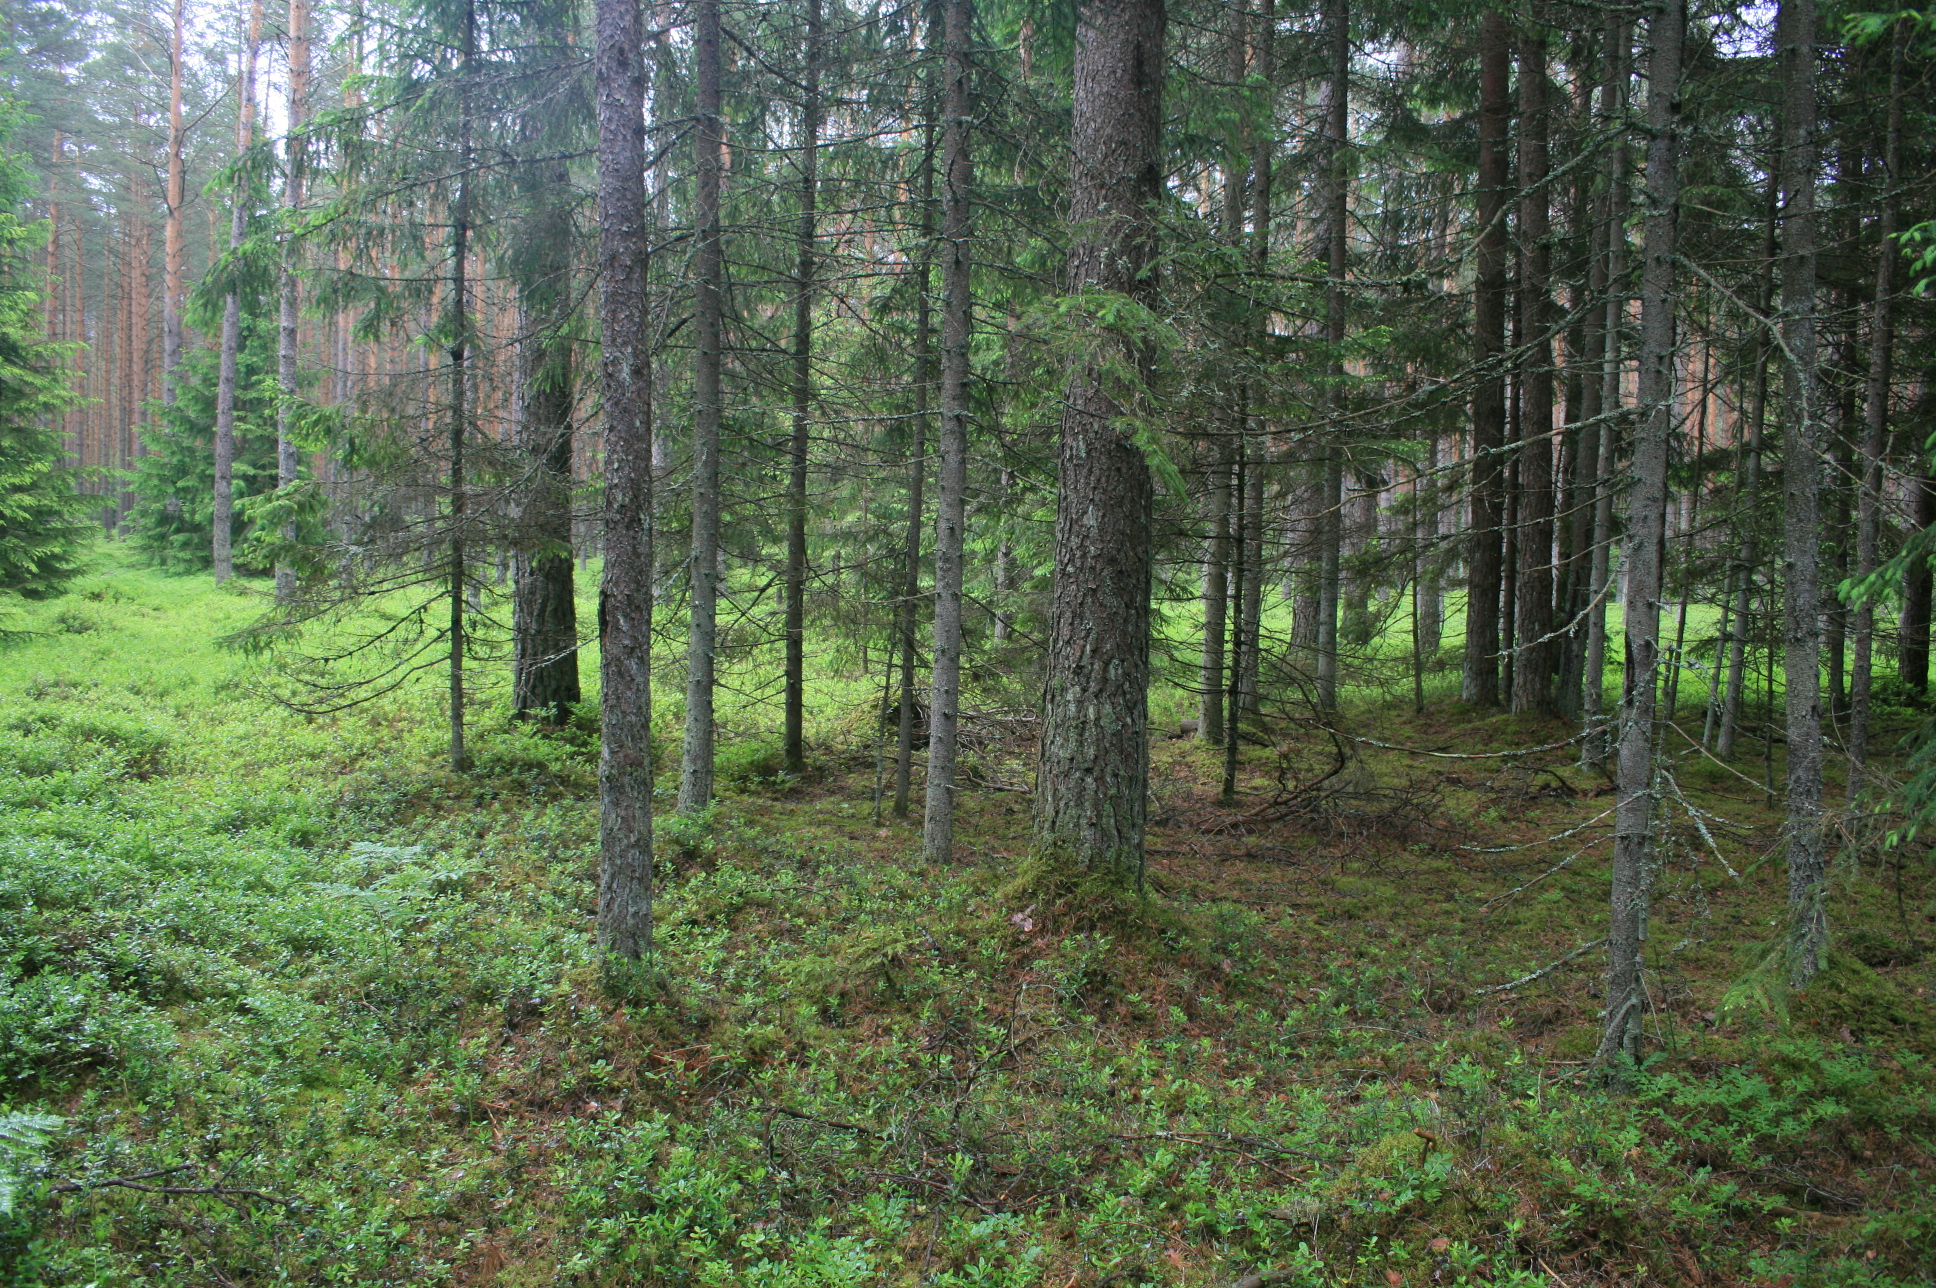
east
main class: Woodland
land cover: Other coniferous woodland
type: hemiboreal forest and nemoral coniferous forest and mixed broadleaved-coniferous forest
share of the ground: > 75 %
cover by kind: coniferous forest trees 85 %, shrubs 5 %, herbaceous plants 5 %, lichens and mosses 5 %
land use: Forestry
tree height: > 5 m
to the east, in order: Other coniferous woodland; Tracks; Other coniferous woodland
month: June
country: LT
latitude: 55.0925
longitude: 22.3921
